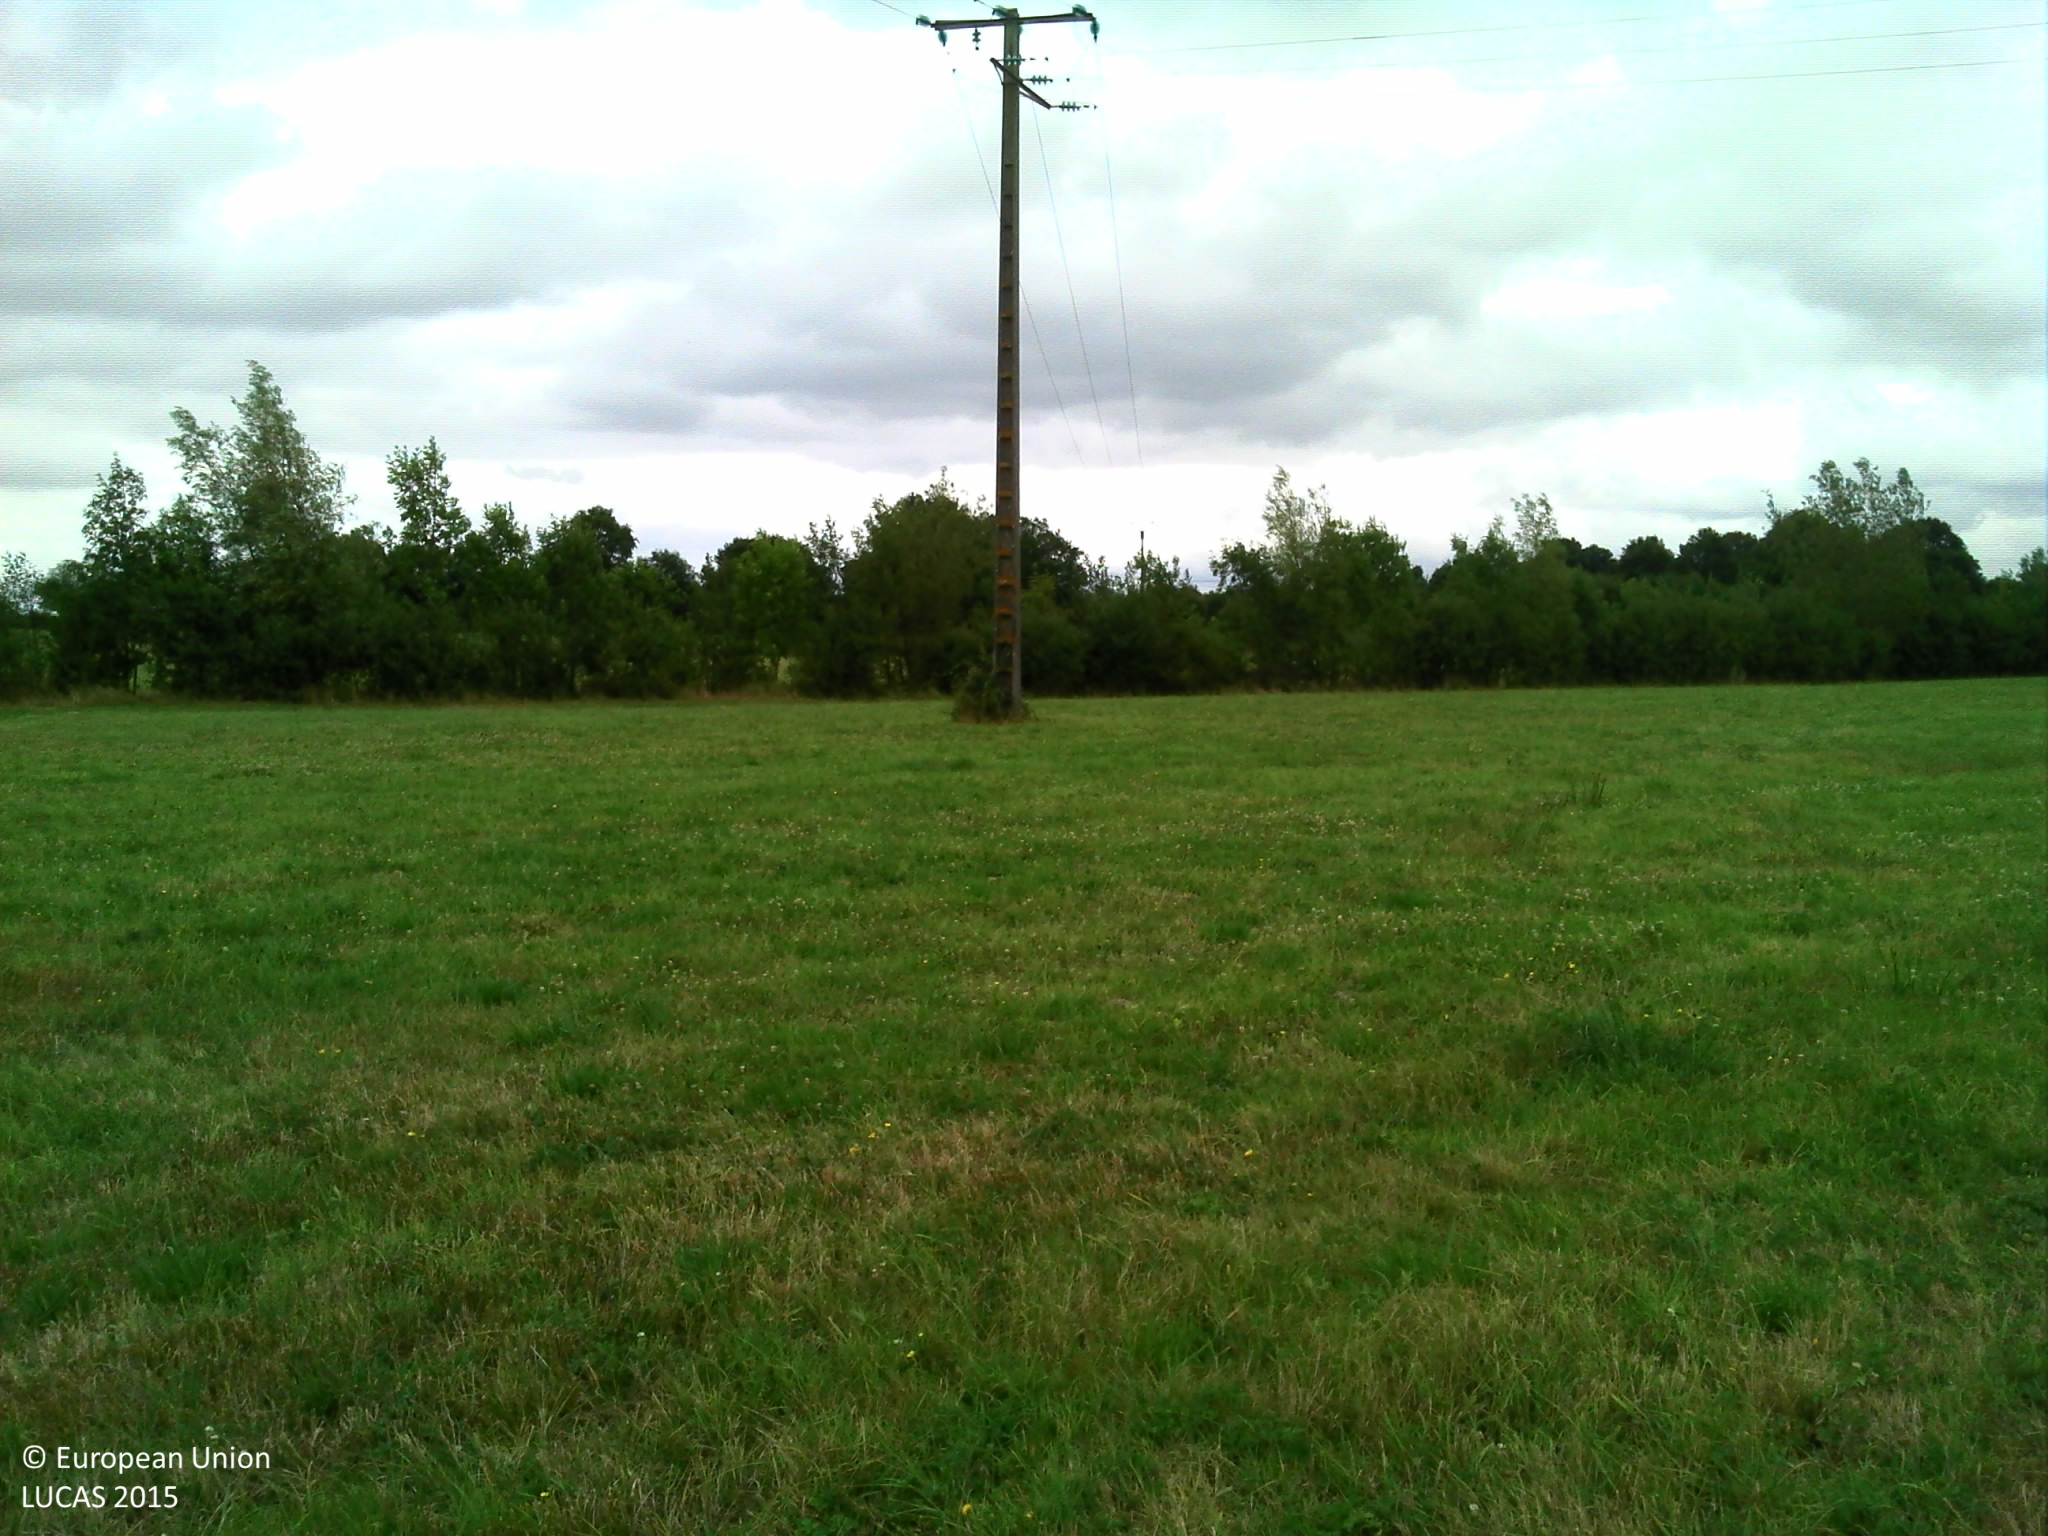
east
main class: Grassland
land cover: Grassland without tree/shrub cover
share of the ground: > 75 %
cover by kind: herbaceous plants 100 %
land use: Agriculture (excluding fallow land and kitchen gardens)
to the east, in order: Grassland without tree/shrub cover; Electric lines; Grassland without tree/shrub cover; Ditches and canals; Lines of trees; Fences; Grassland without tree/shrub cover; Fences; Lines of trees; Grassland without tree/shrub cover; Managed hedges
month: July
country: FR
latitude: 48.4320
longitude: -0.0722
